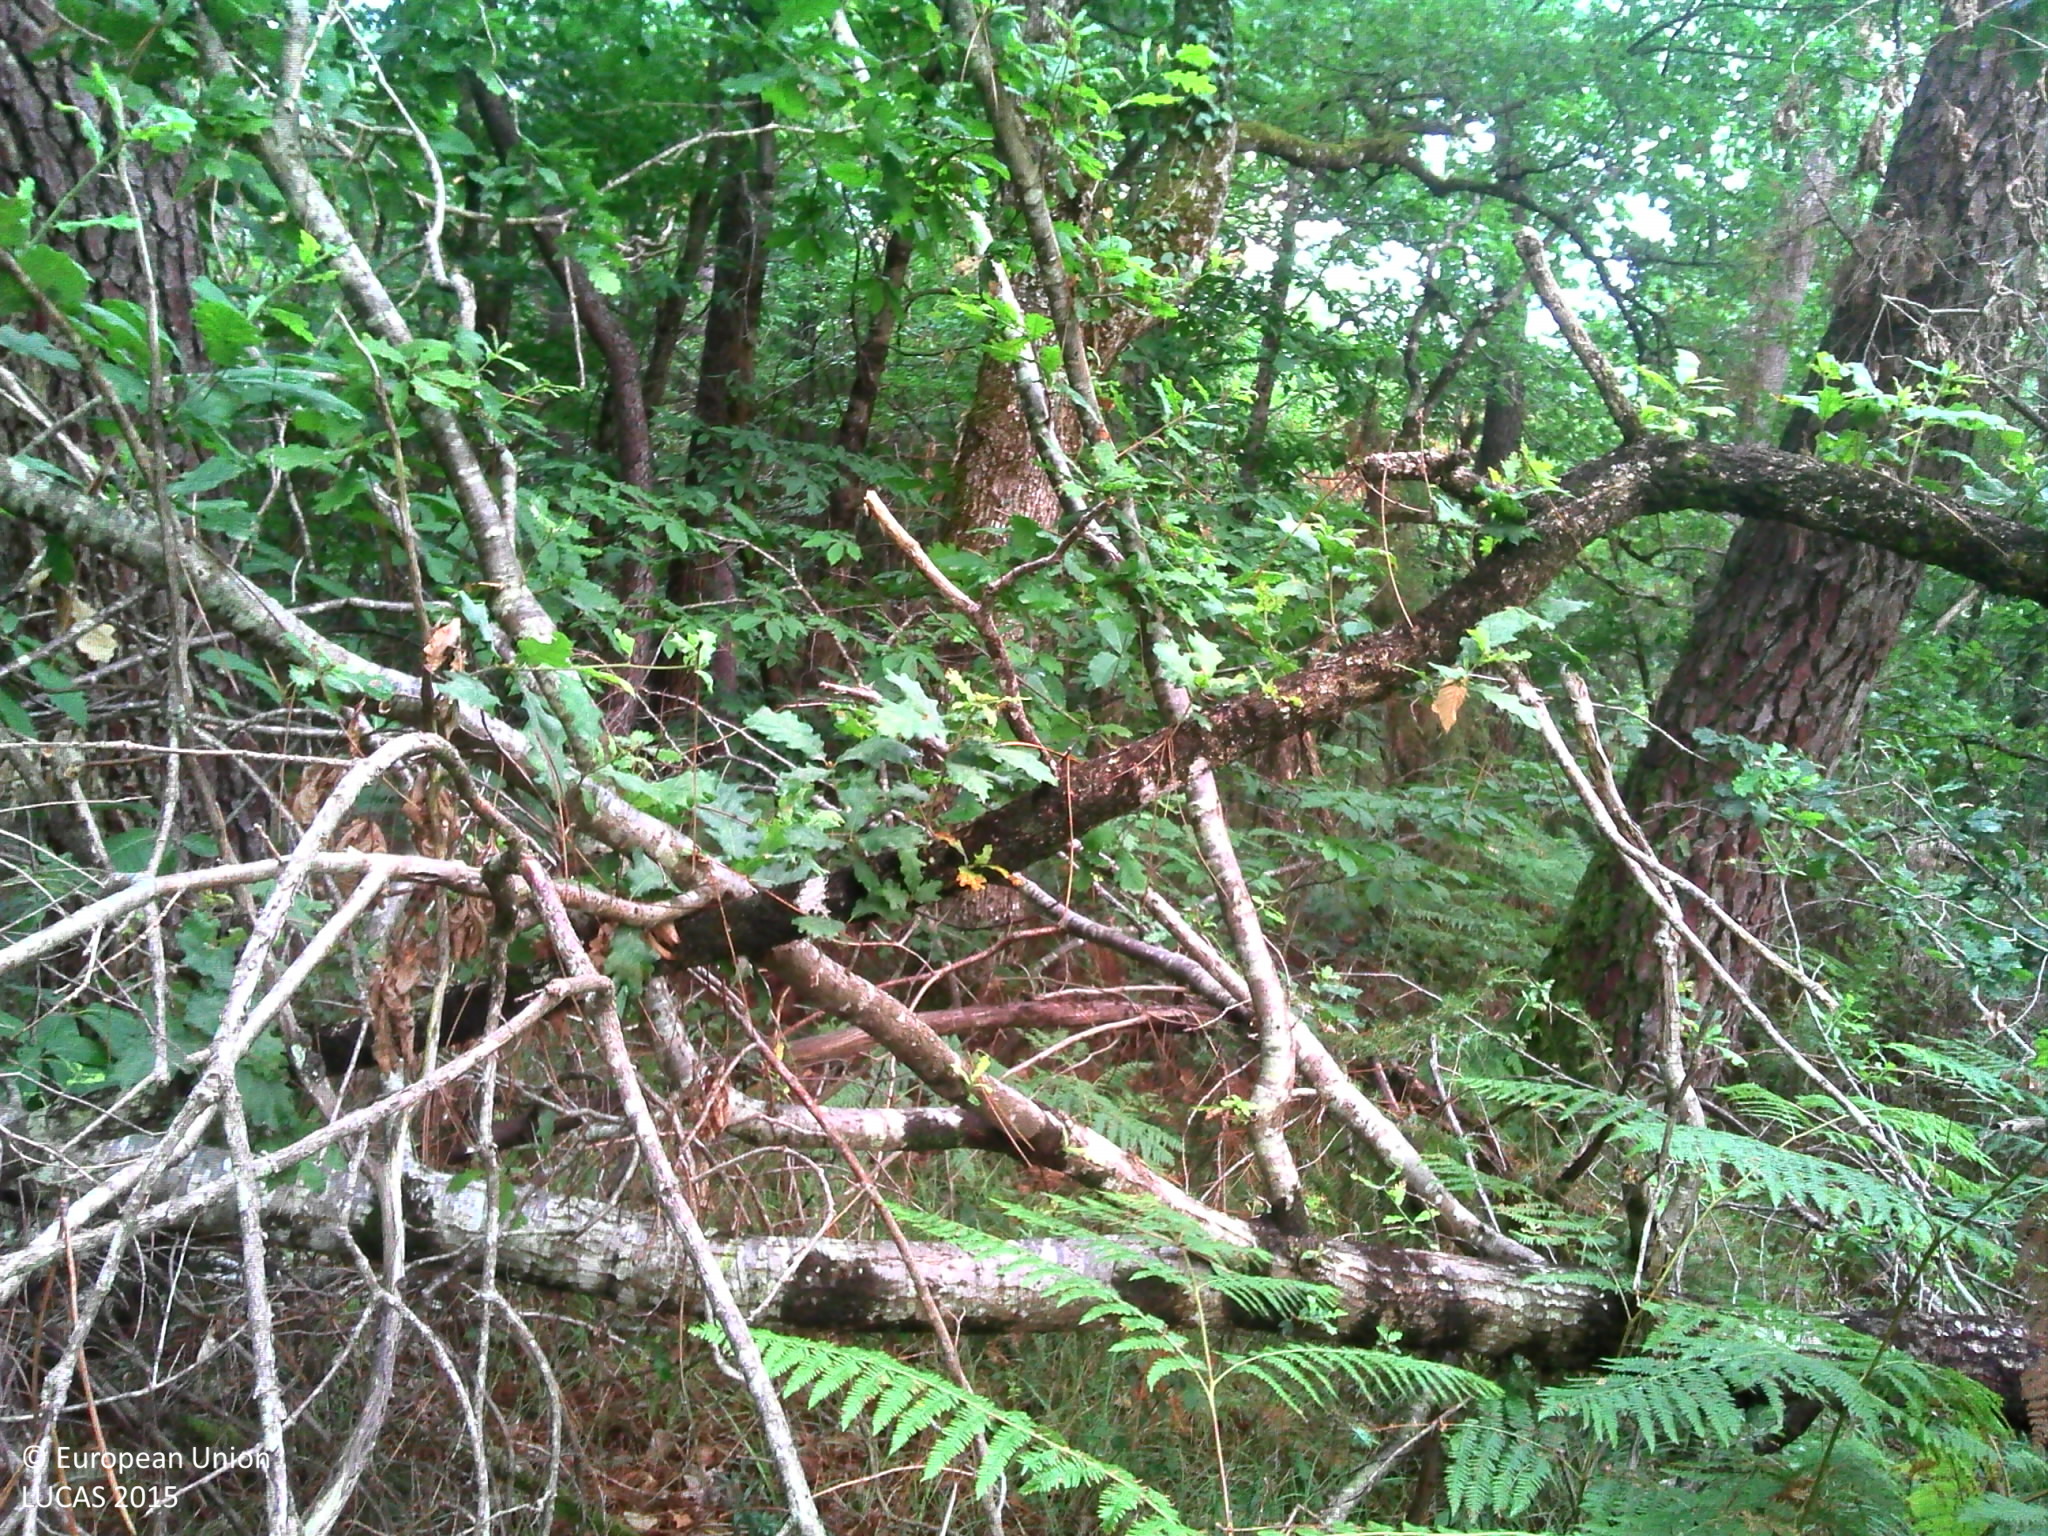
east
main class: Woodland
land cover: Pine dominated mixed woodland
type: thermophilous deciduous forest
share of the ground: > 75 %
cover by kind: broadleaved forest trees 40 %, coniferous forest trees 20 %, herbaceous plants 20 %, lichens and mosses 10 %, consolidated bare surface 10 %
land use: Forestry
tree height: > 5 m
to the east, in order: Pine dominated mixed woodland; Tracks; Pine dominated mixed woodland
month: August
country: FR
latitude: 45.4395
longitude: 0.7206
